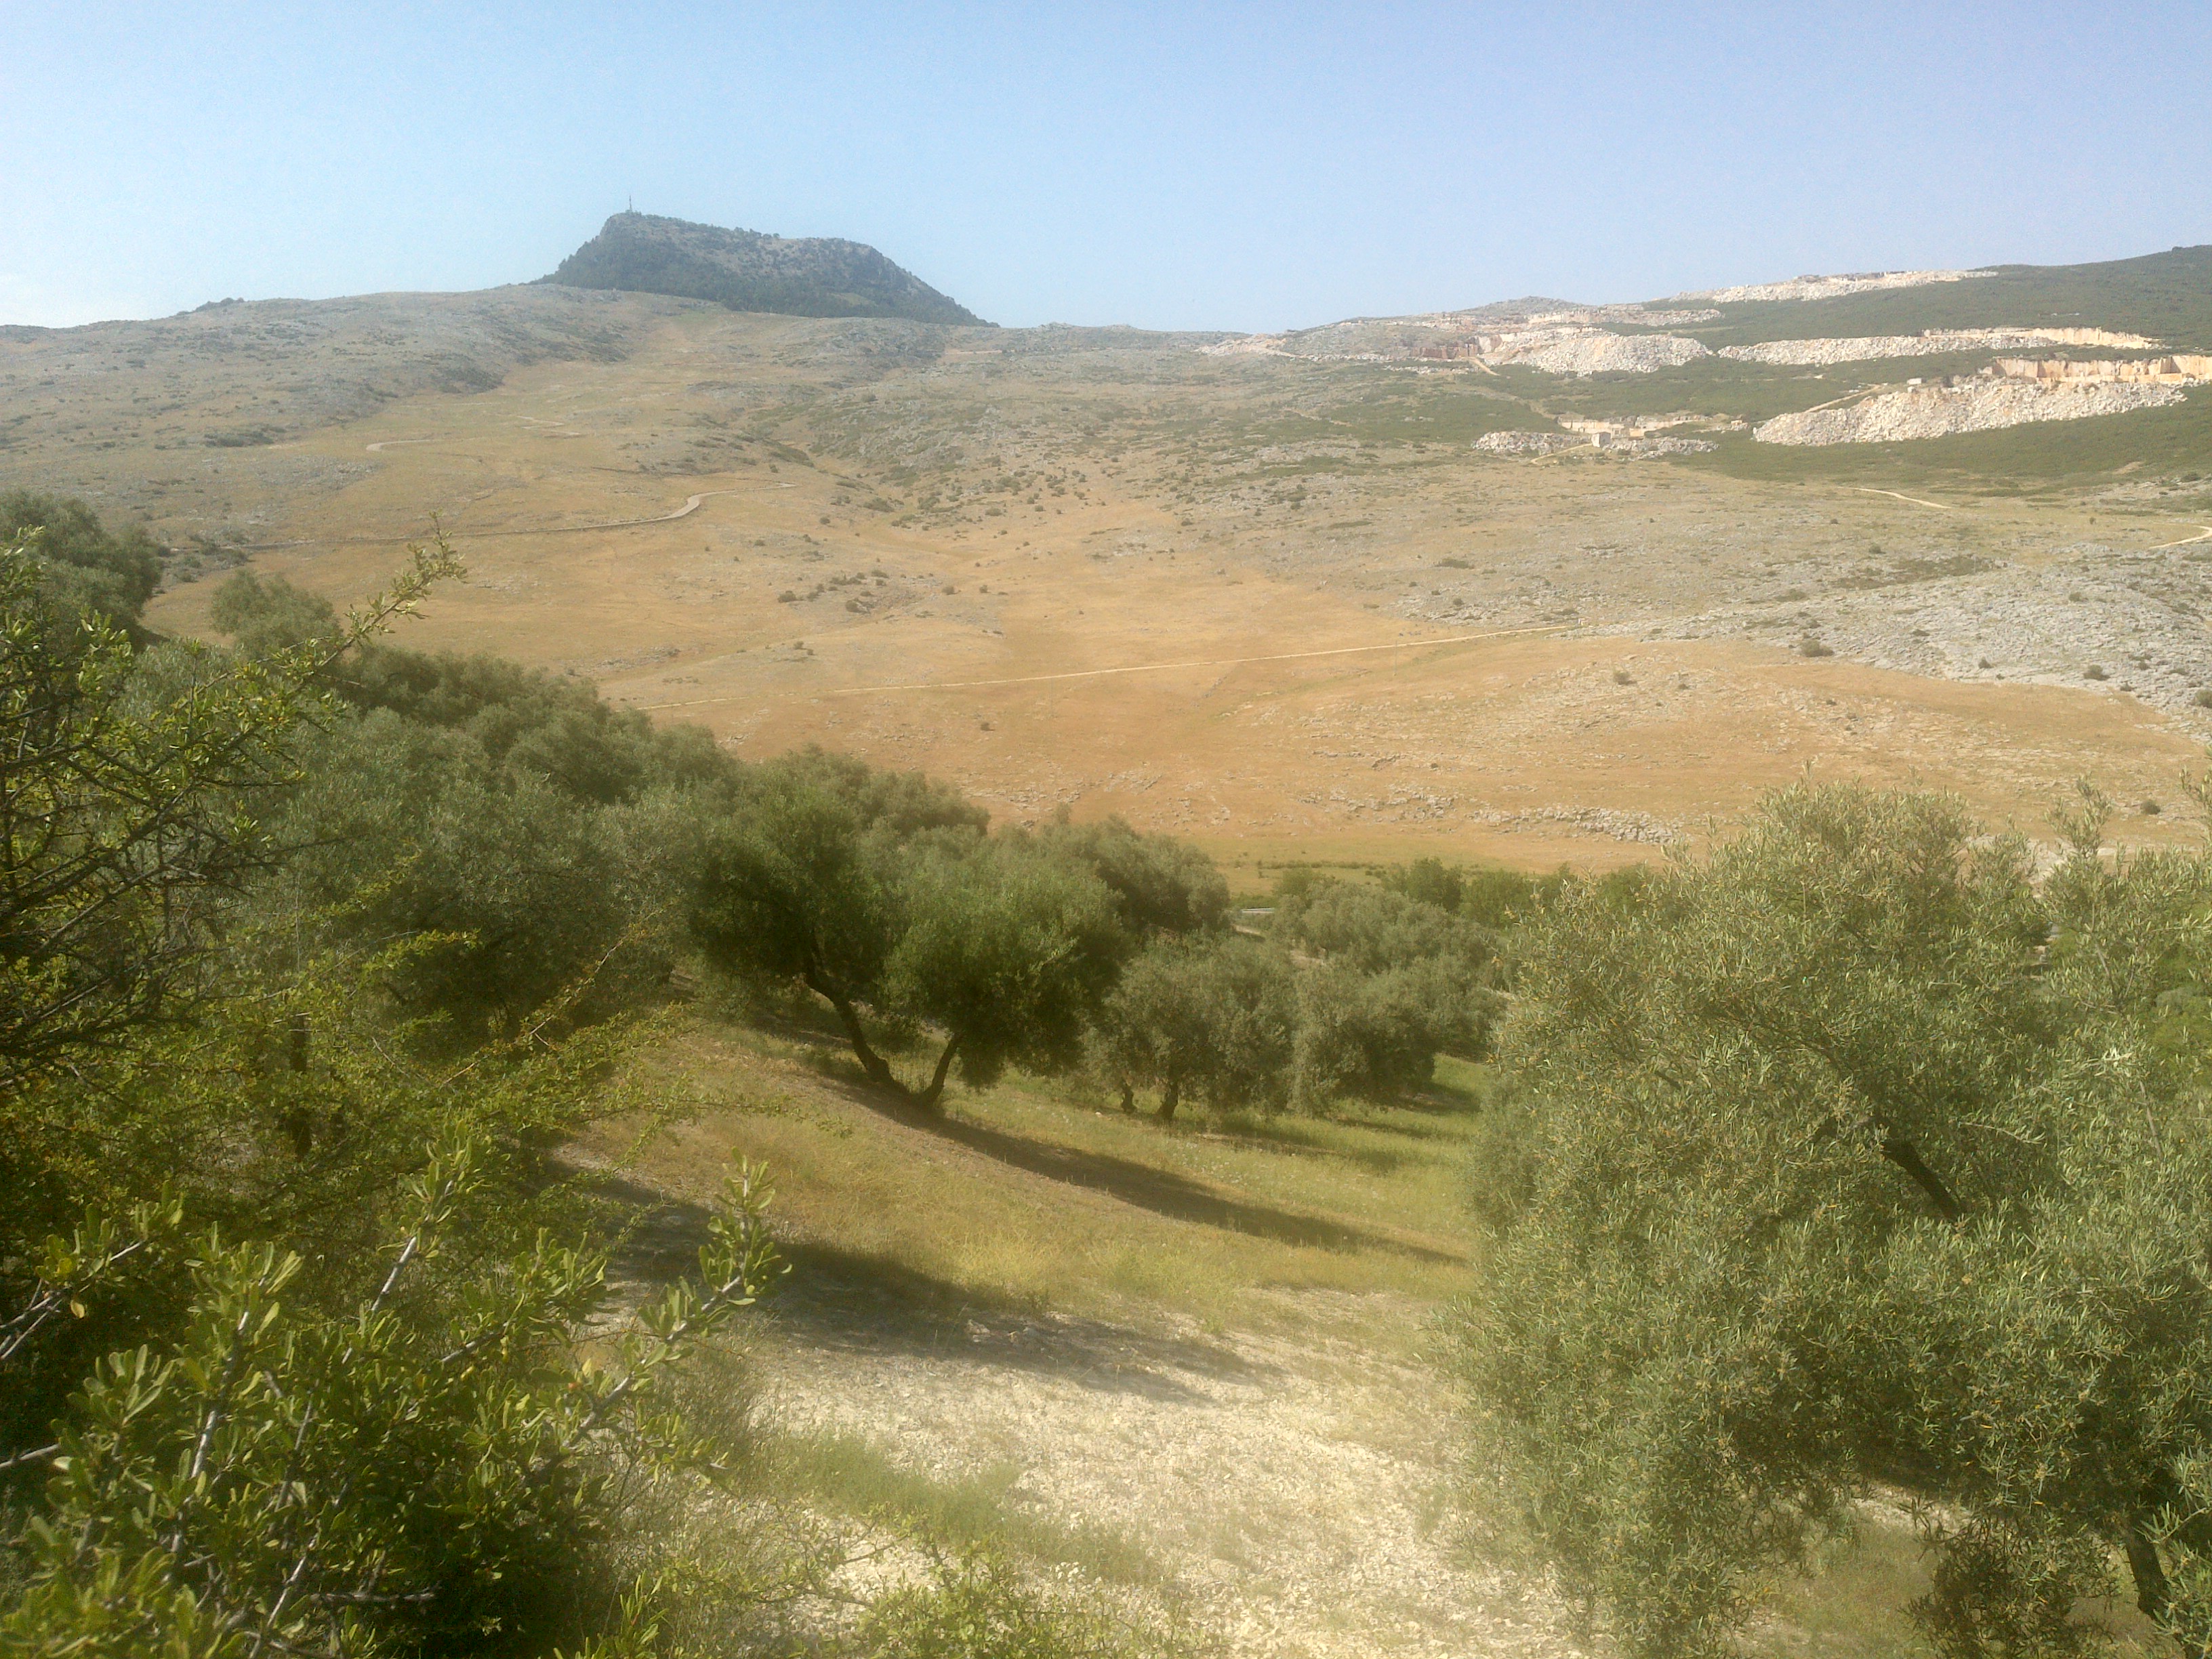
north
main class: Shrubland
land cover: Shrubland without tree cover
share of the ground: > 75 %
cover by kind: shrubs 75 %, herbaceous plants 20 %, unconsolidated bare surface 5 %
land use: Semi-natural and natural areas not in use
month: May
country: ES
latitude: 37.4587
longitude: -4.3711
